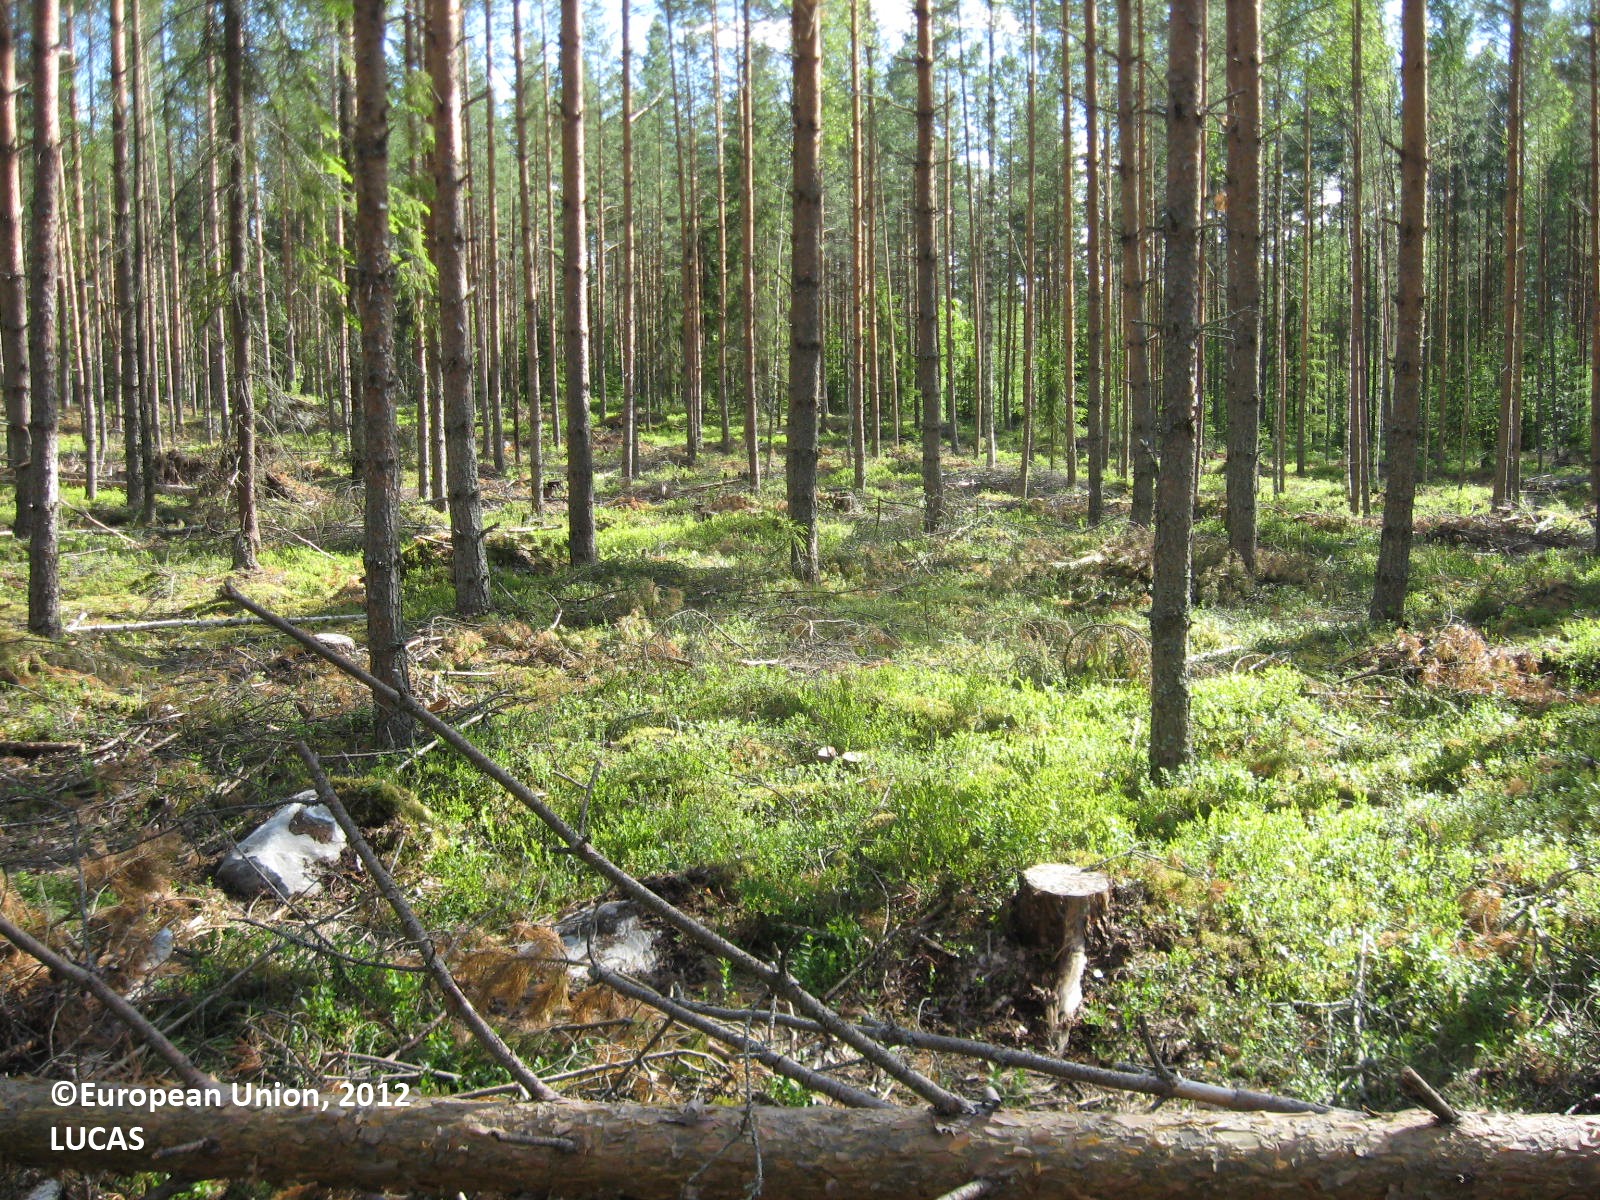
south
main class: Woodland
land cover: Pine dominated coniferous woodland
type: boreal forest
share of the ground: > 75 %
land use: Forestry
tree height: > 5 m
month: June
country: FI
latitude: 62.8183
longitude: 22.7520
